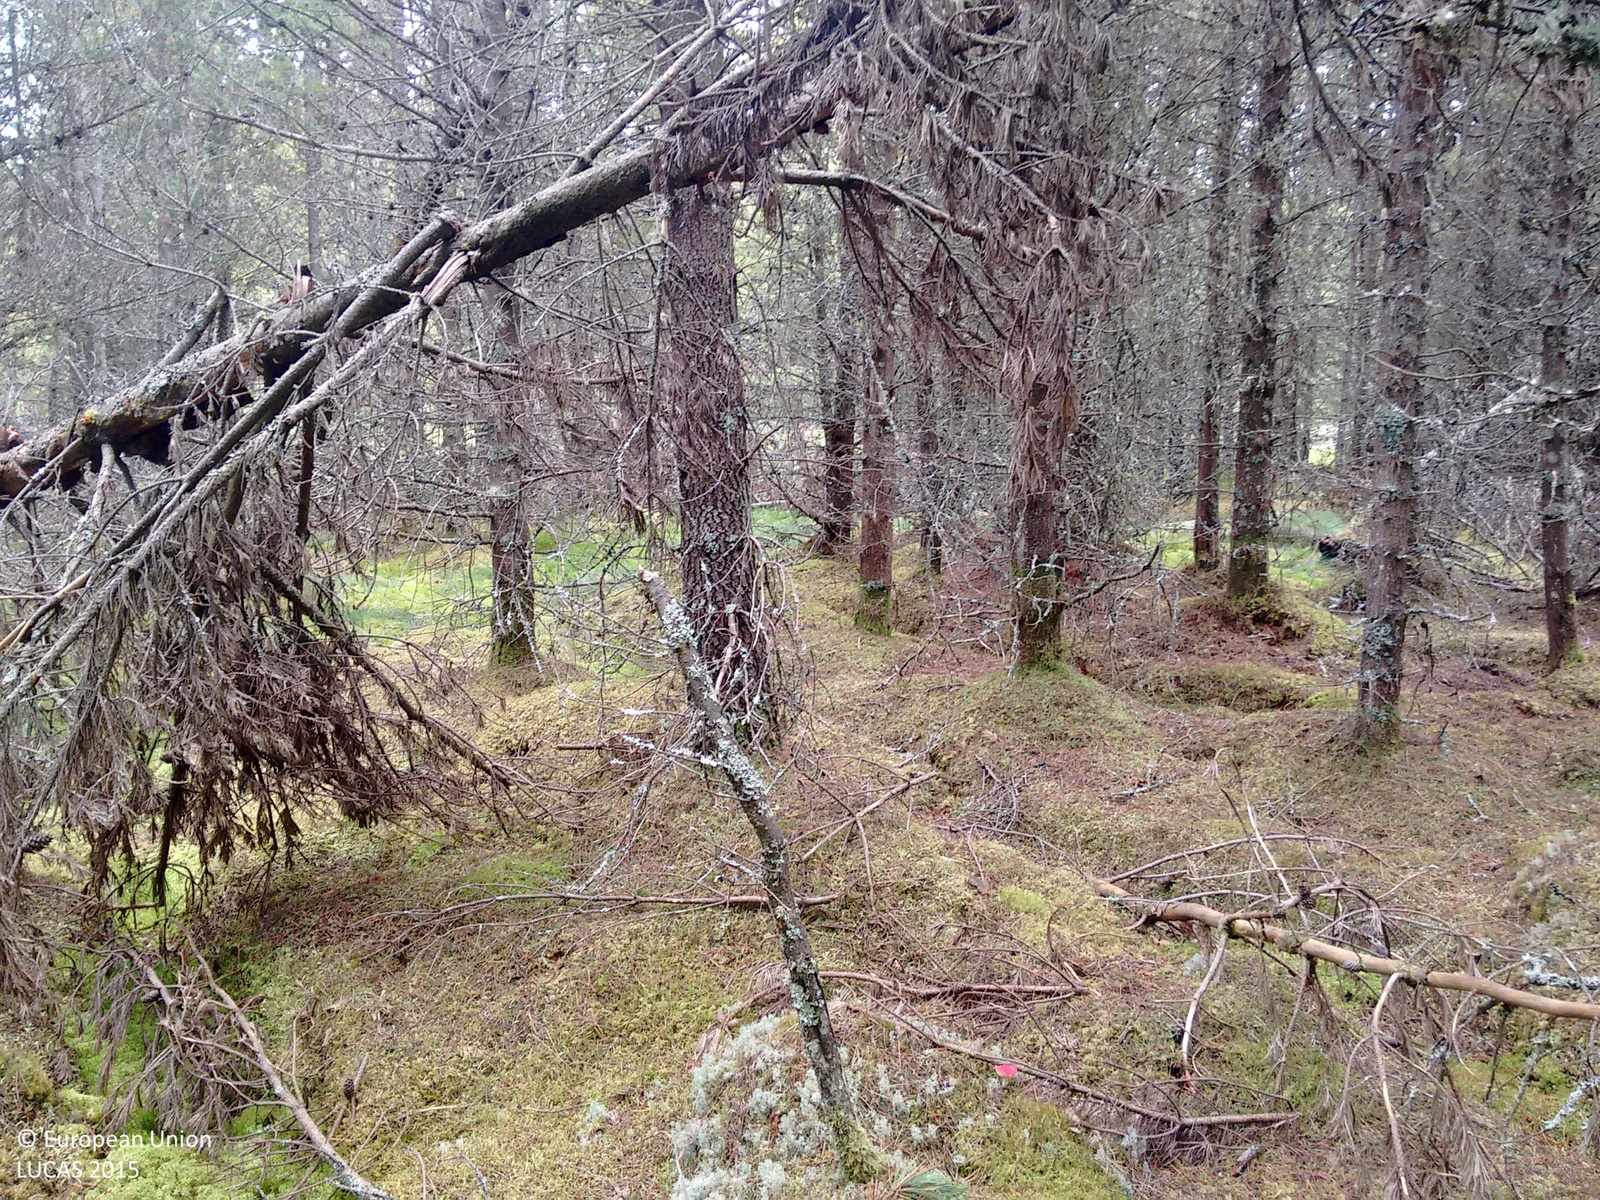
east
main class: Woodland
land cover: Pine dominated coniferous woodland
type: exotic forest
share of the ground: > 75 %
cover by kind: coniferous forest trees 100 %
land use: Forestry
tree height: > 5 m
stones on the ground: < 10 %
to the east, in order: Pine dominated coniferous woodland; Shrubland without tree cover; Fences; Shrubland with sparse tree cover
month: September
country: GB
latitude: 57.5074
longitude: -3.4043
